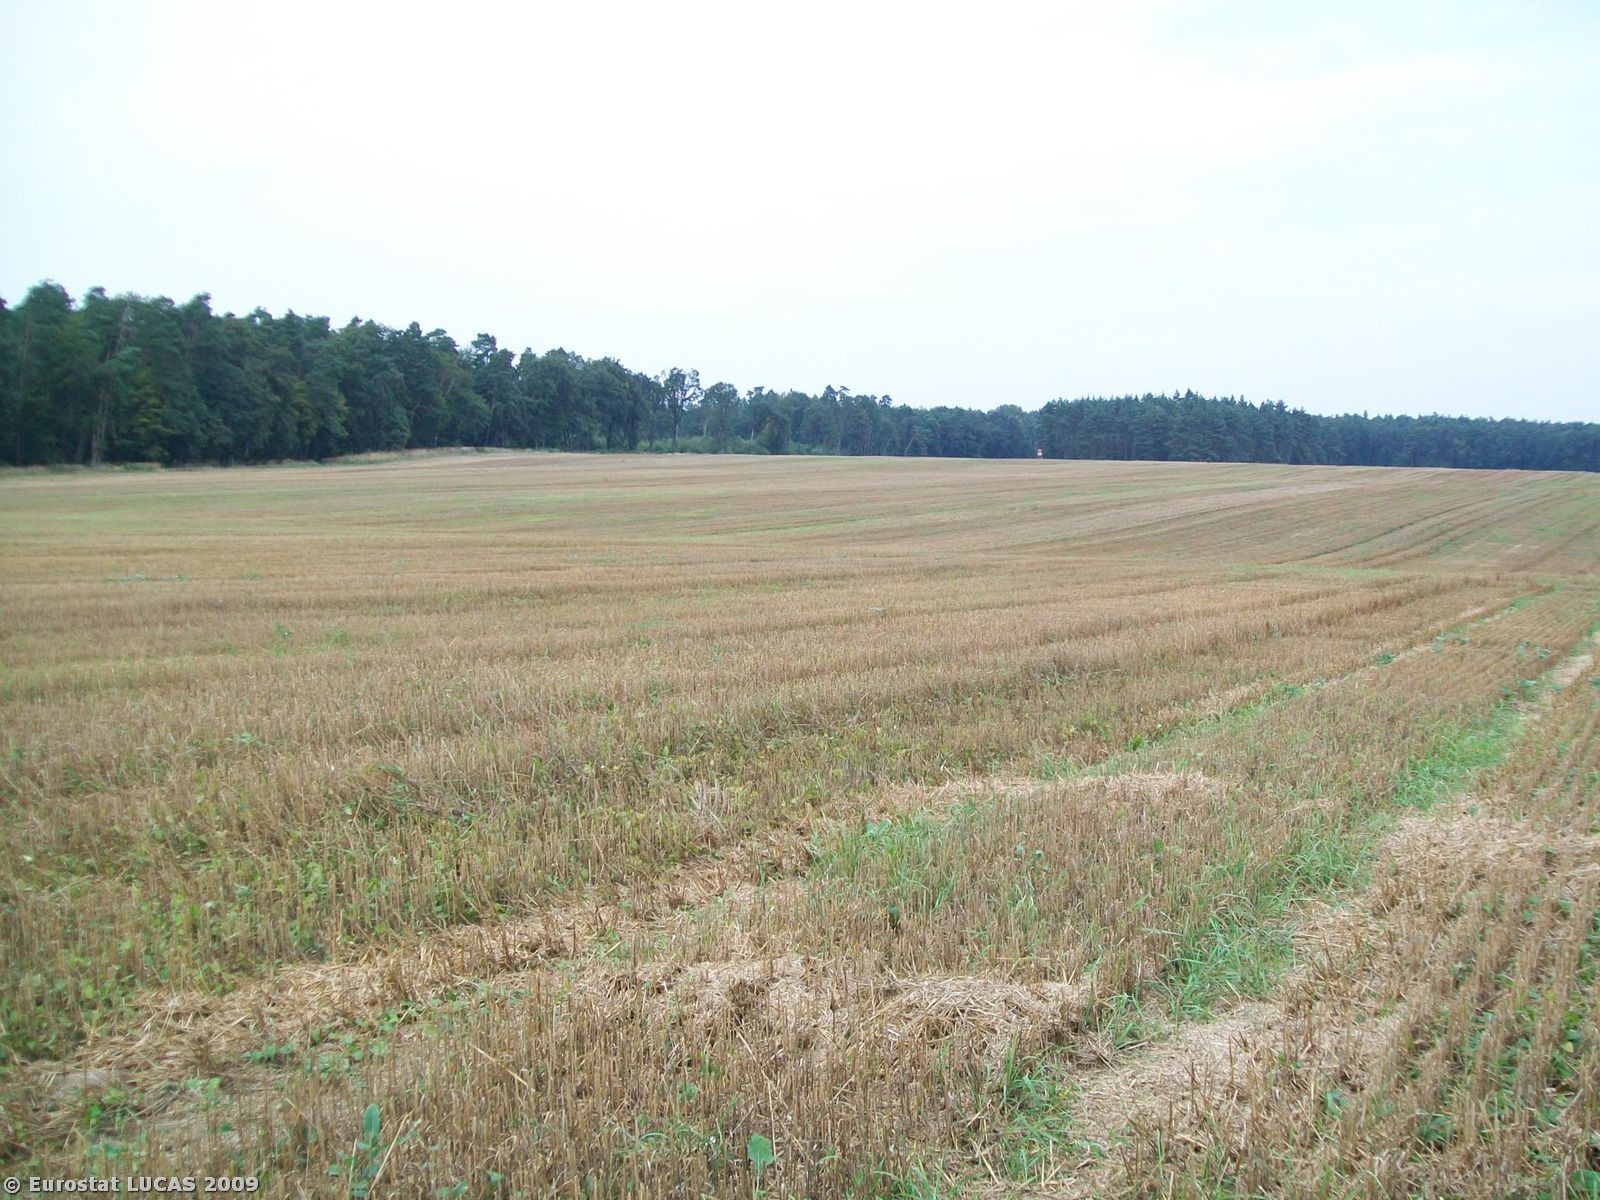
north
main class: Cropland
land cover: Common wheat
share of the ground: < 10 %
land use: Agriculture (excluding fallow land and kitchen gardens)
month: August
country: PL
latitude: 51.0995
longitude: 17.9411
